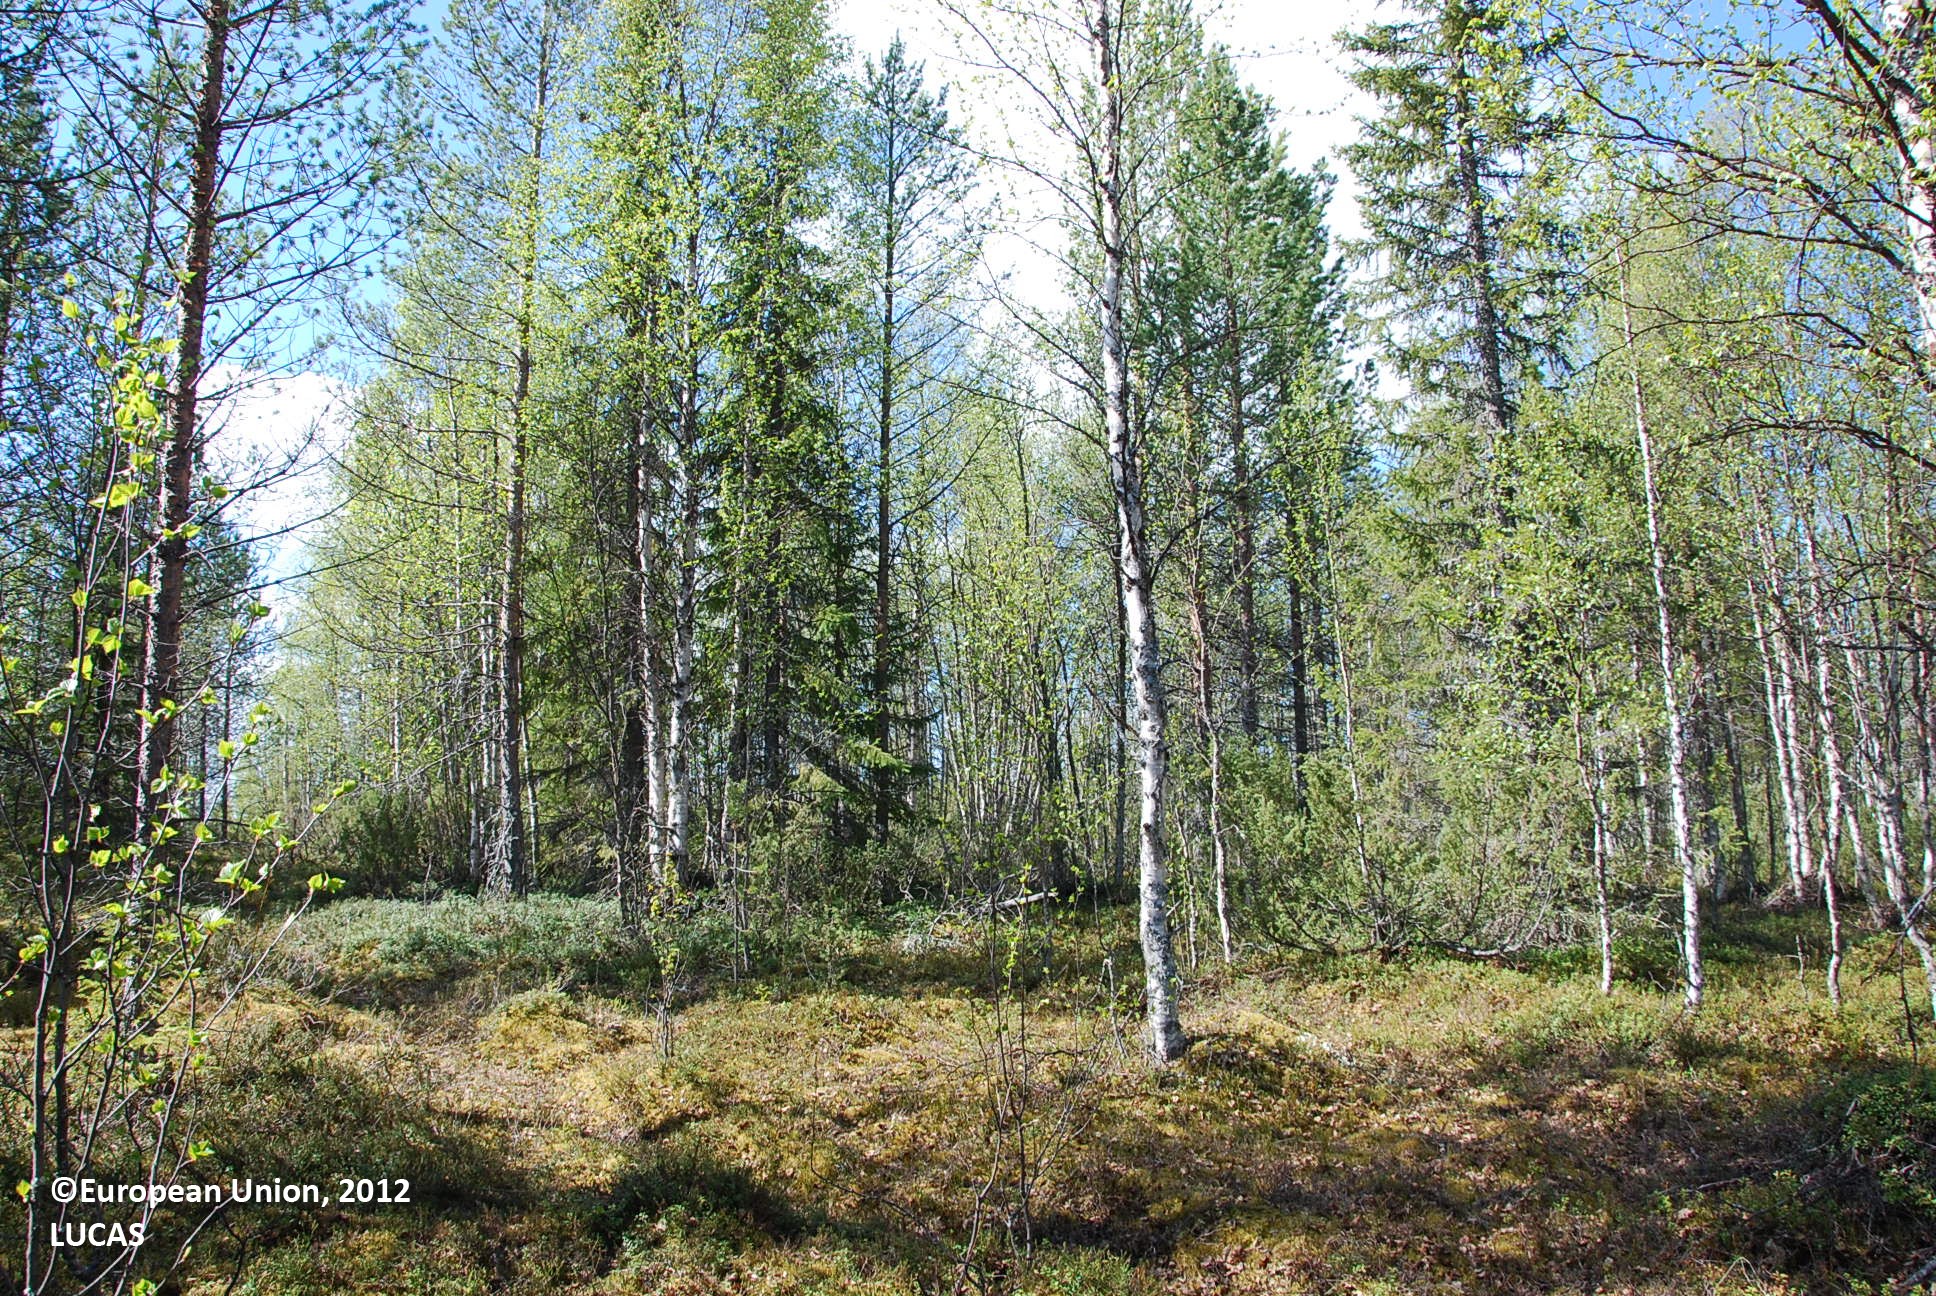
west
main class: Woodland
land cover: Other mixed woodland
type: boreal forest
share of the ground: > 75 %
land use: Forestry
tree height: > 5 m
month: June
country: FI
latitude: 67.0064
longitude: 28.0863
